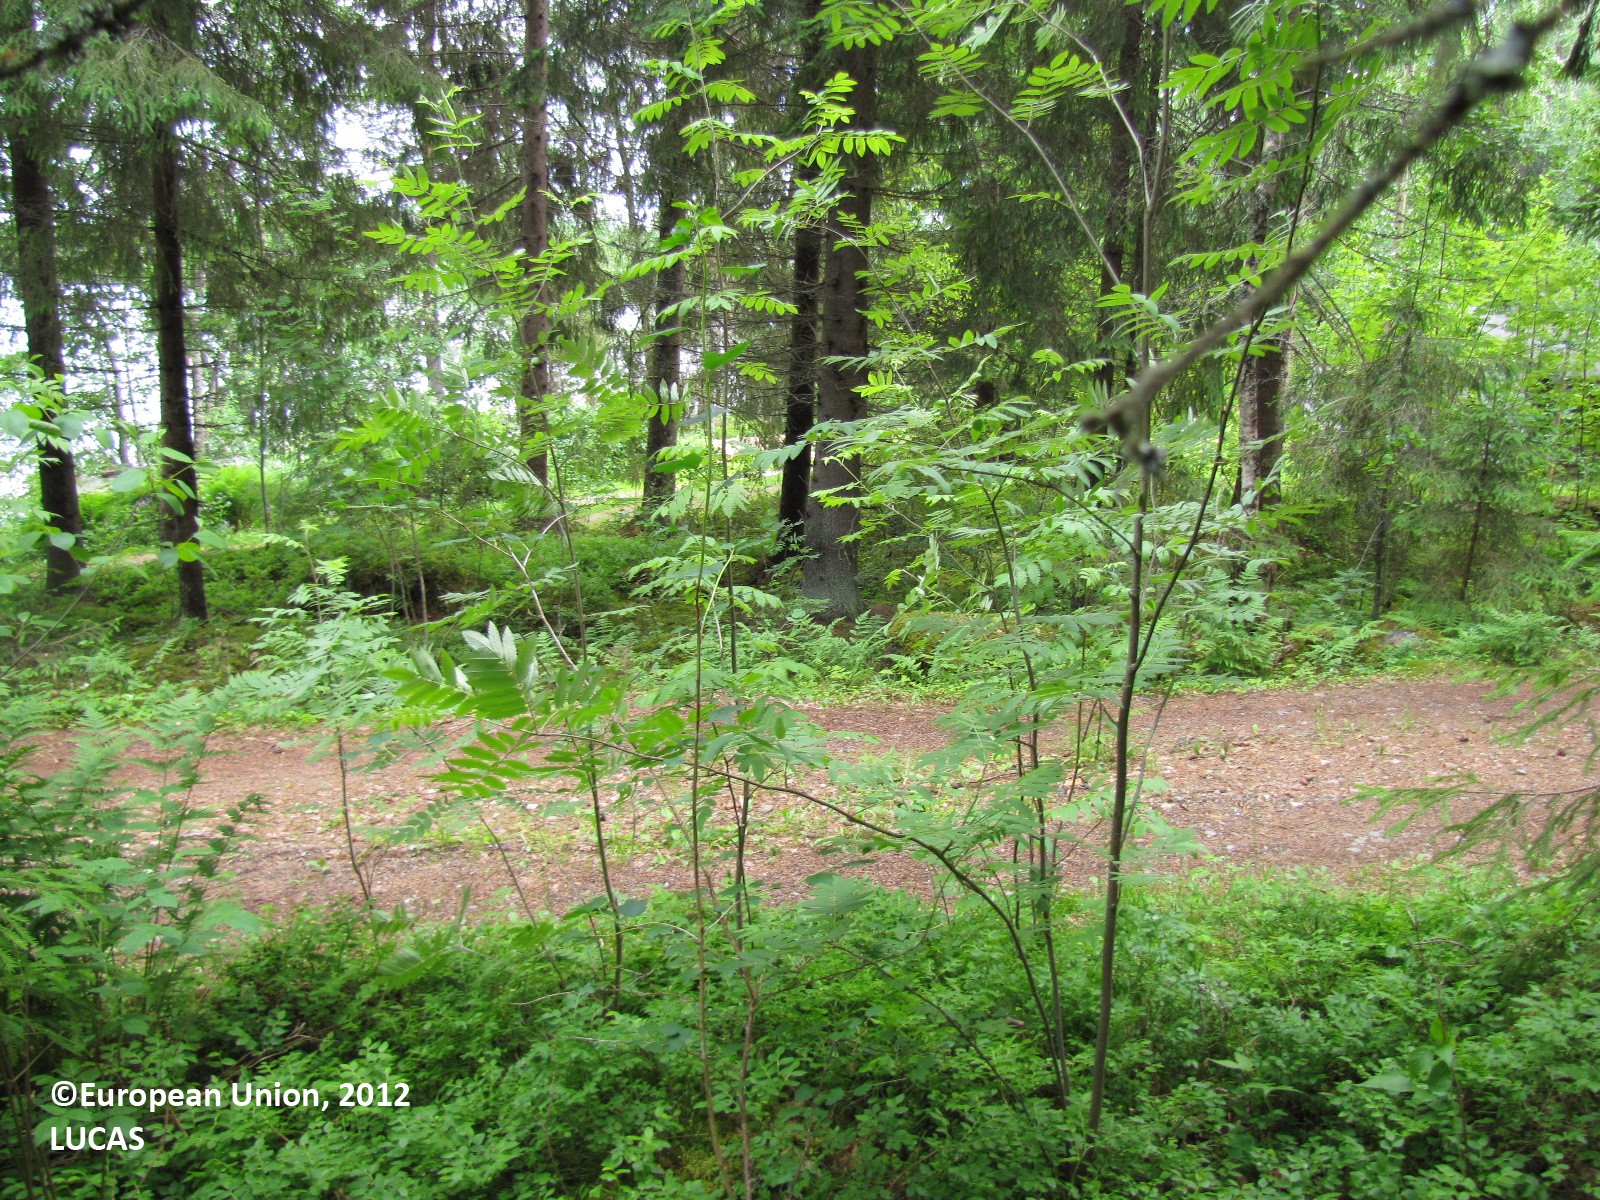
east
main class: Woodland
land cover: Spruce dominated coniferous woodland
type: boreal forest
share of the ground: > 75 %
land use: Forestry
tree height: > 5 m
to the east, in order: Spruce dominated coniferous woodland; Tracks; Spruce dominated coniferous woodland; Tracks; Shrubland with sparse tree cover; Broadleaved woodland; Inland water bodies
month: June
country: FI
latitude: 61.2984
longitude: 24.6823
